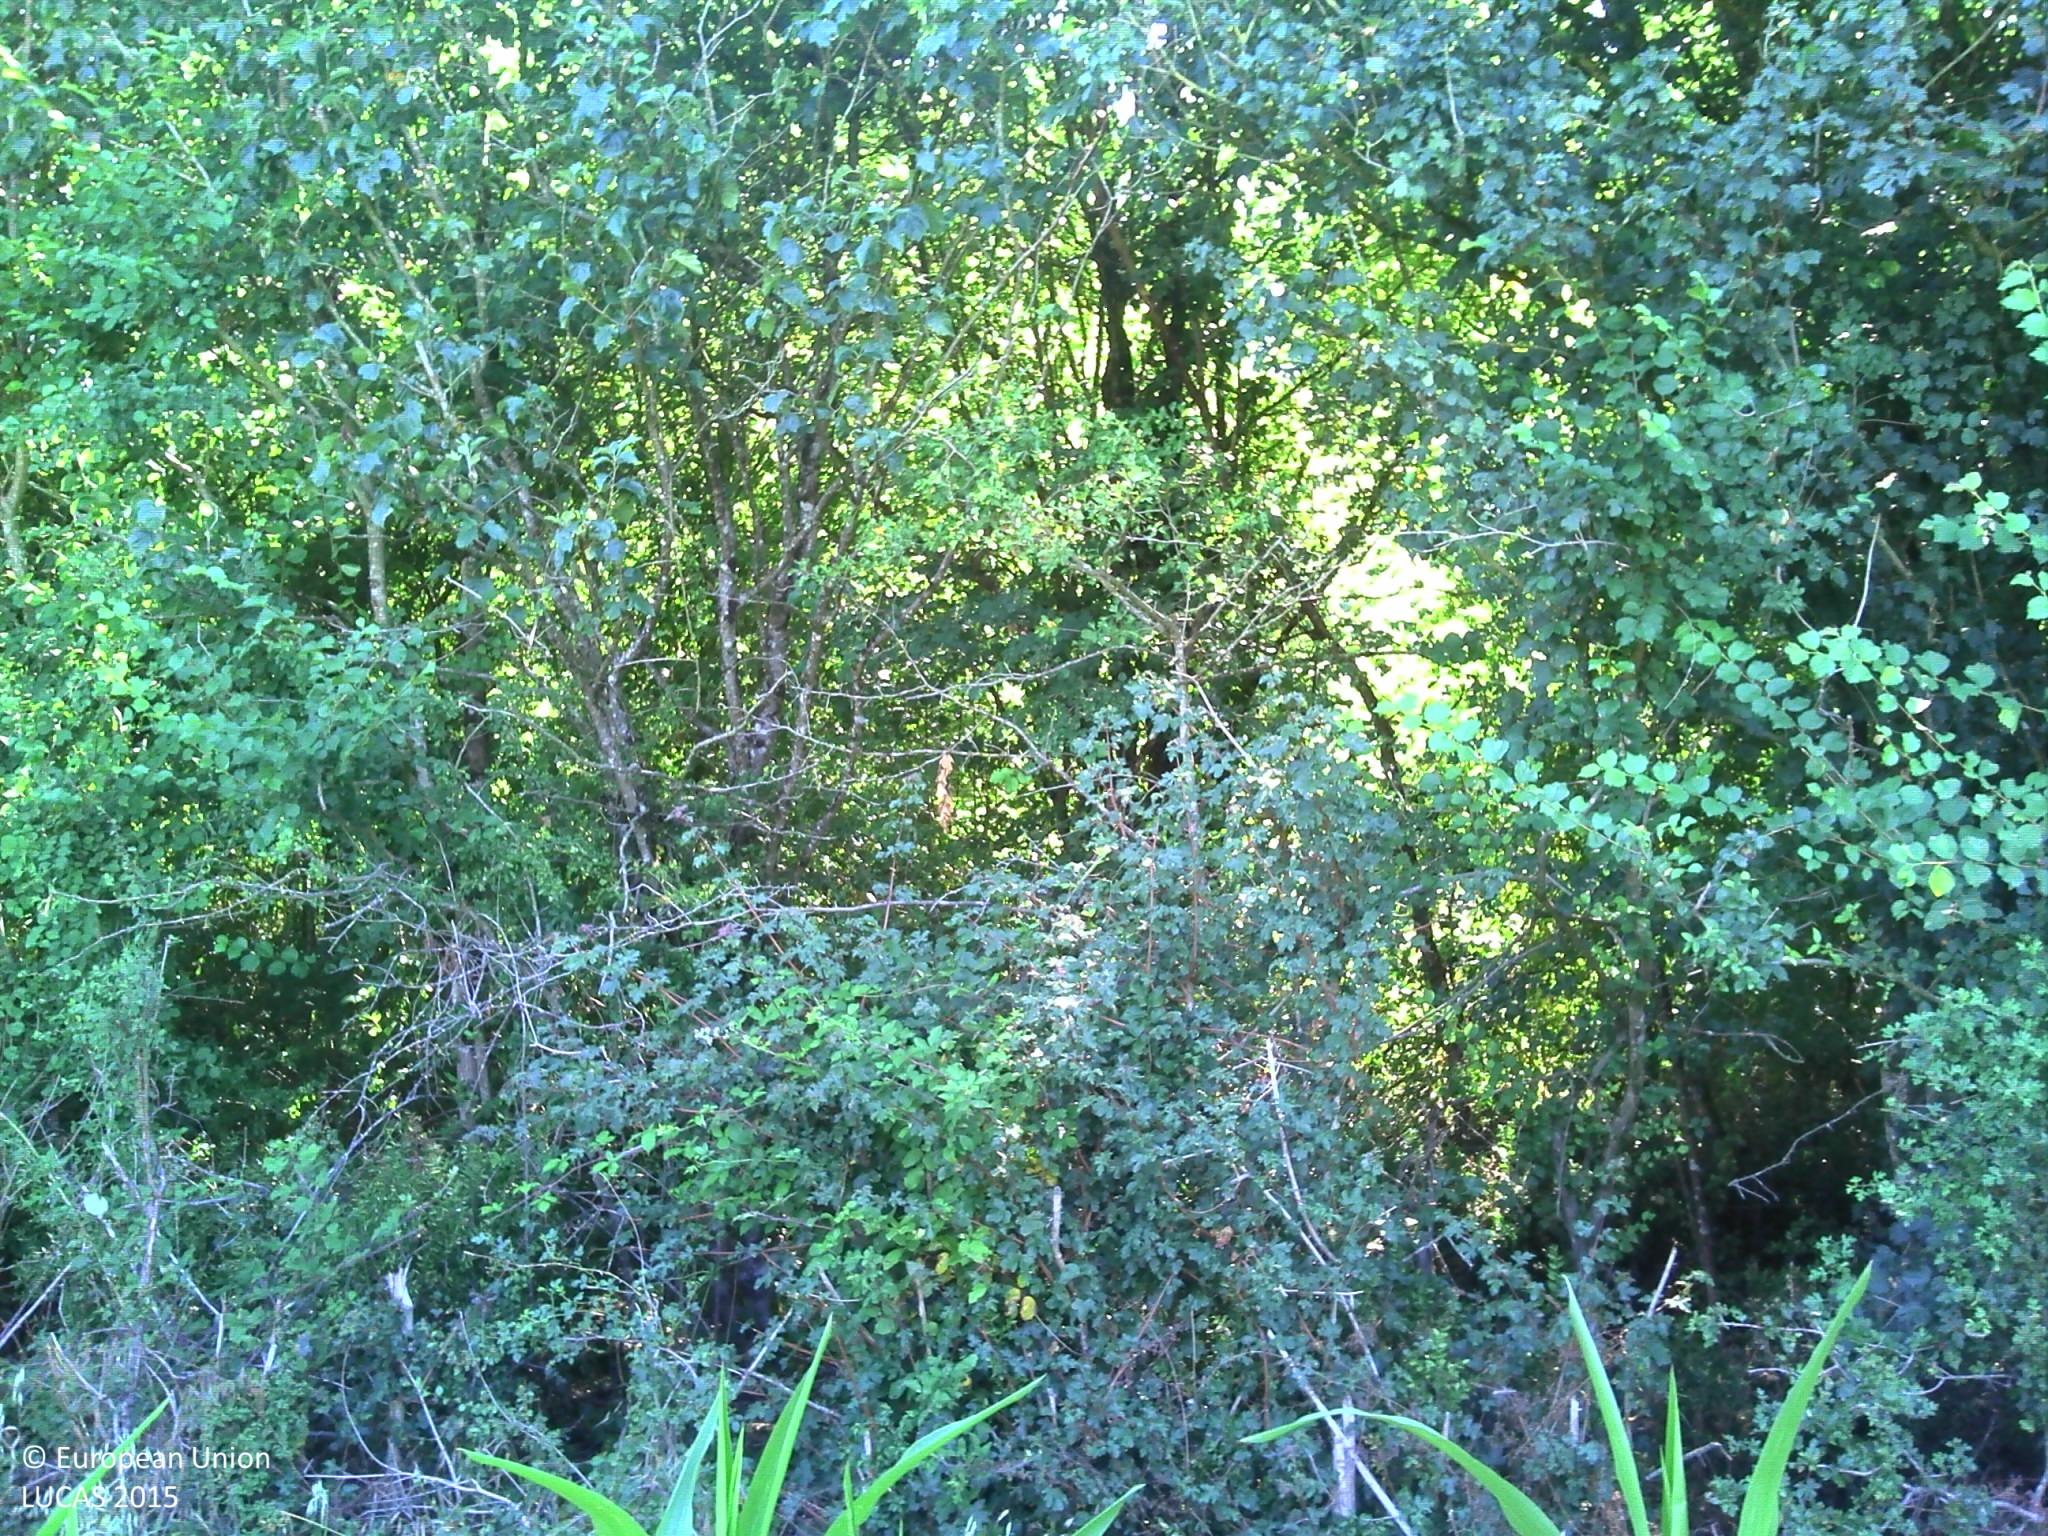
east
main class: Cropland
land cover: Maize
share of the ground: > 75 %
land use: Agriculture (excluding fallow land and kitchen gardens)
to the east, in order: Maize; Grass margins; Broadleaved woodland
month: July
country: FR
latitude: 47.5831
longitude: 0.3639
